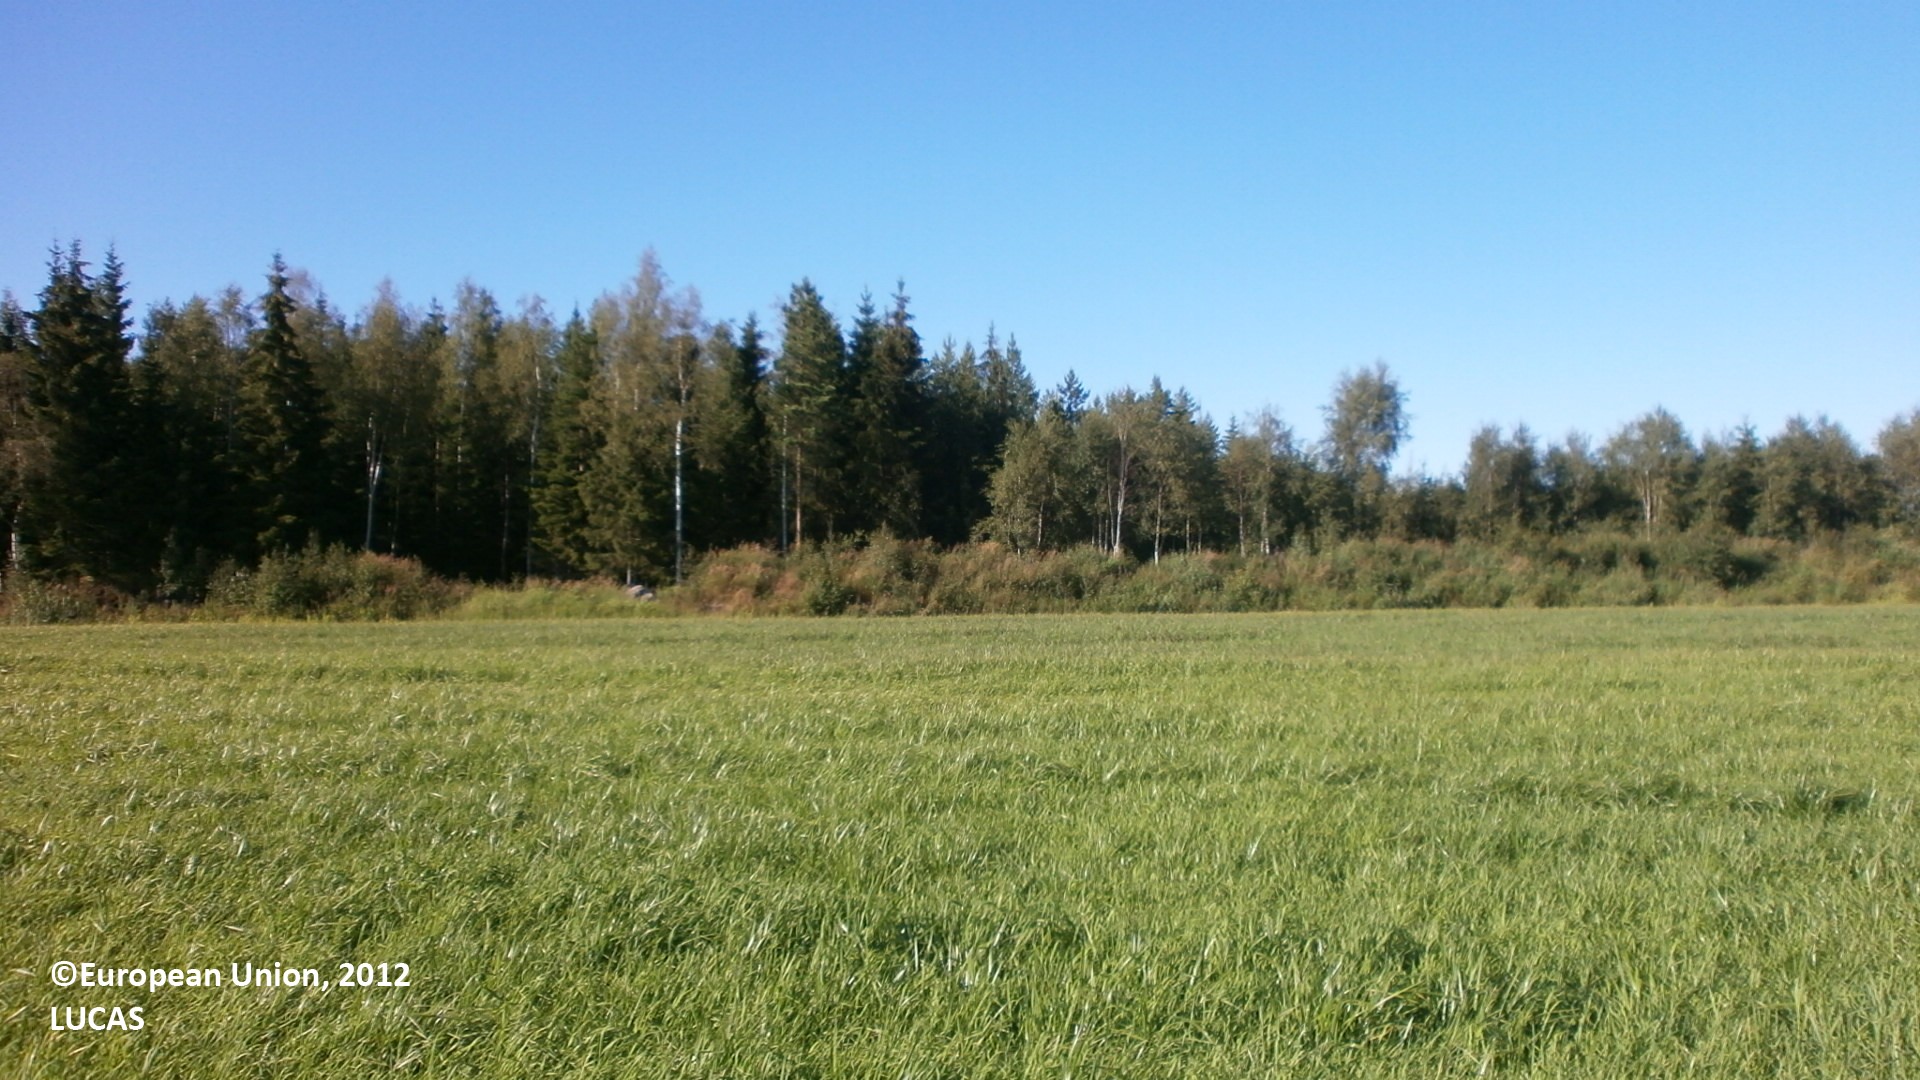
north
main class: Cropland
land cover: Temporary grasslands
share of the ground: > 75 %
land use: Agriculture (excluding fallow land and kitchen gardens)
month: July
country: FI
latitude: 64.2178
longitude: 23.9719
